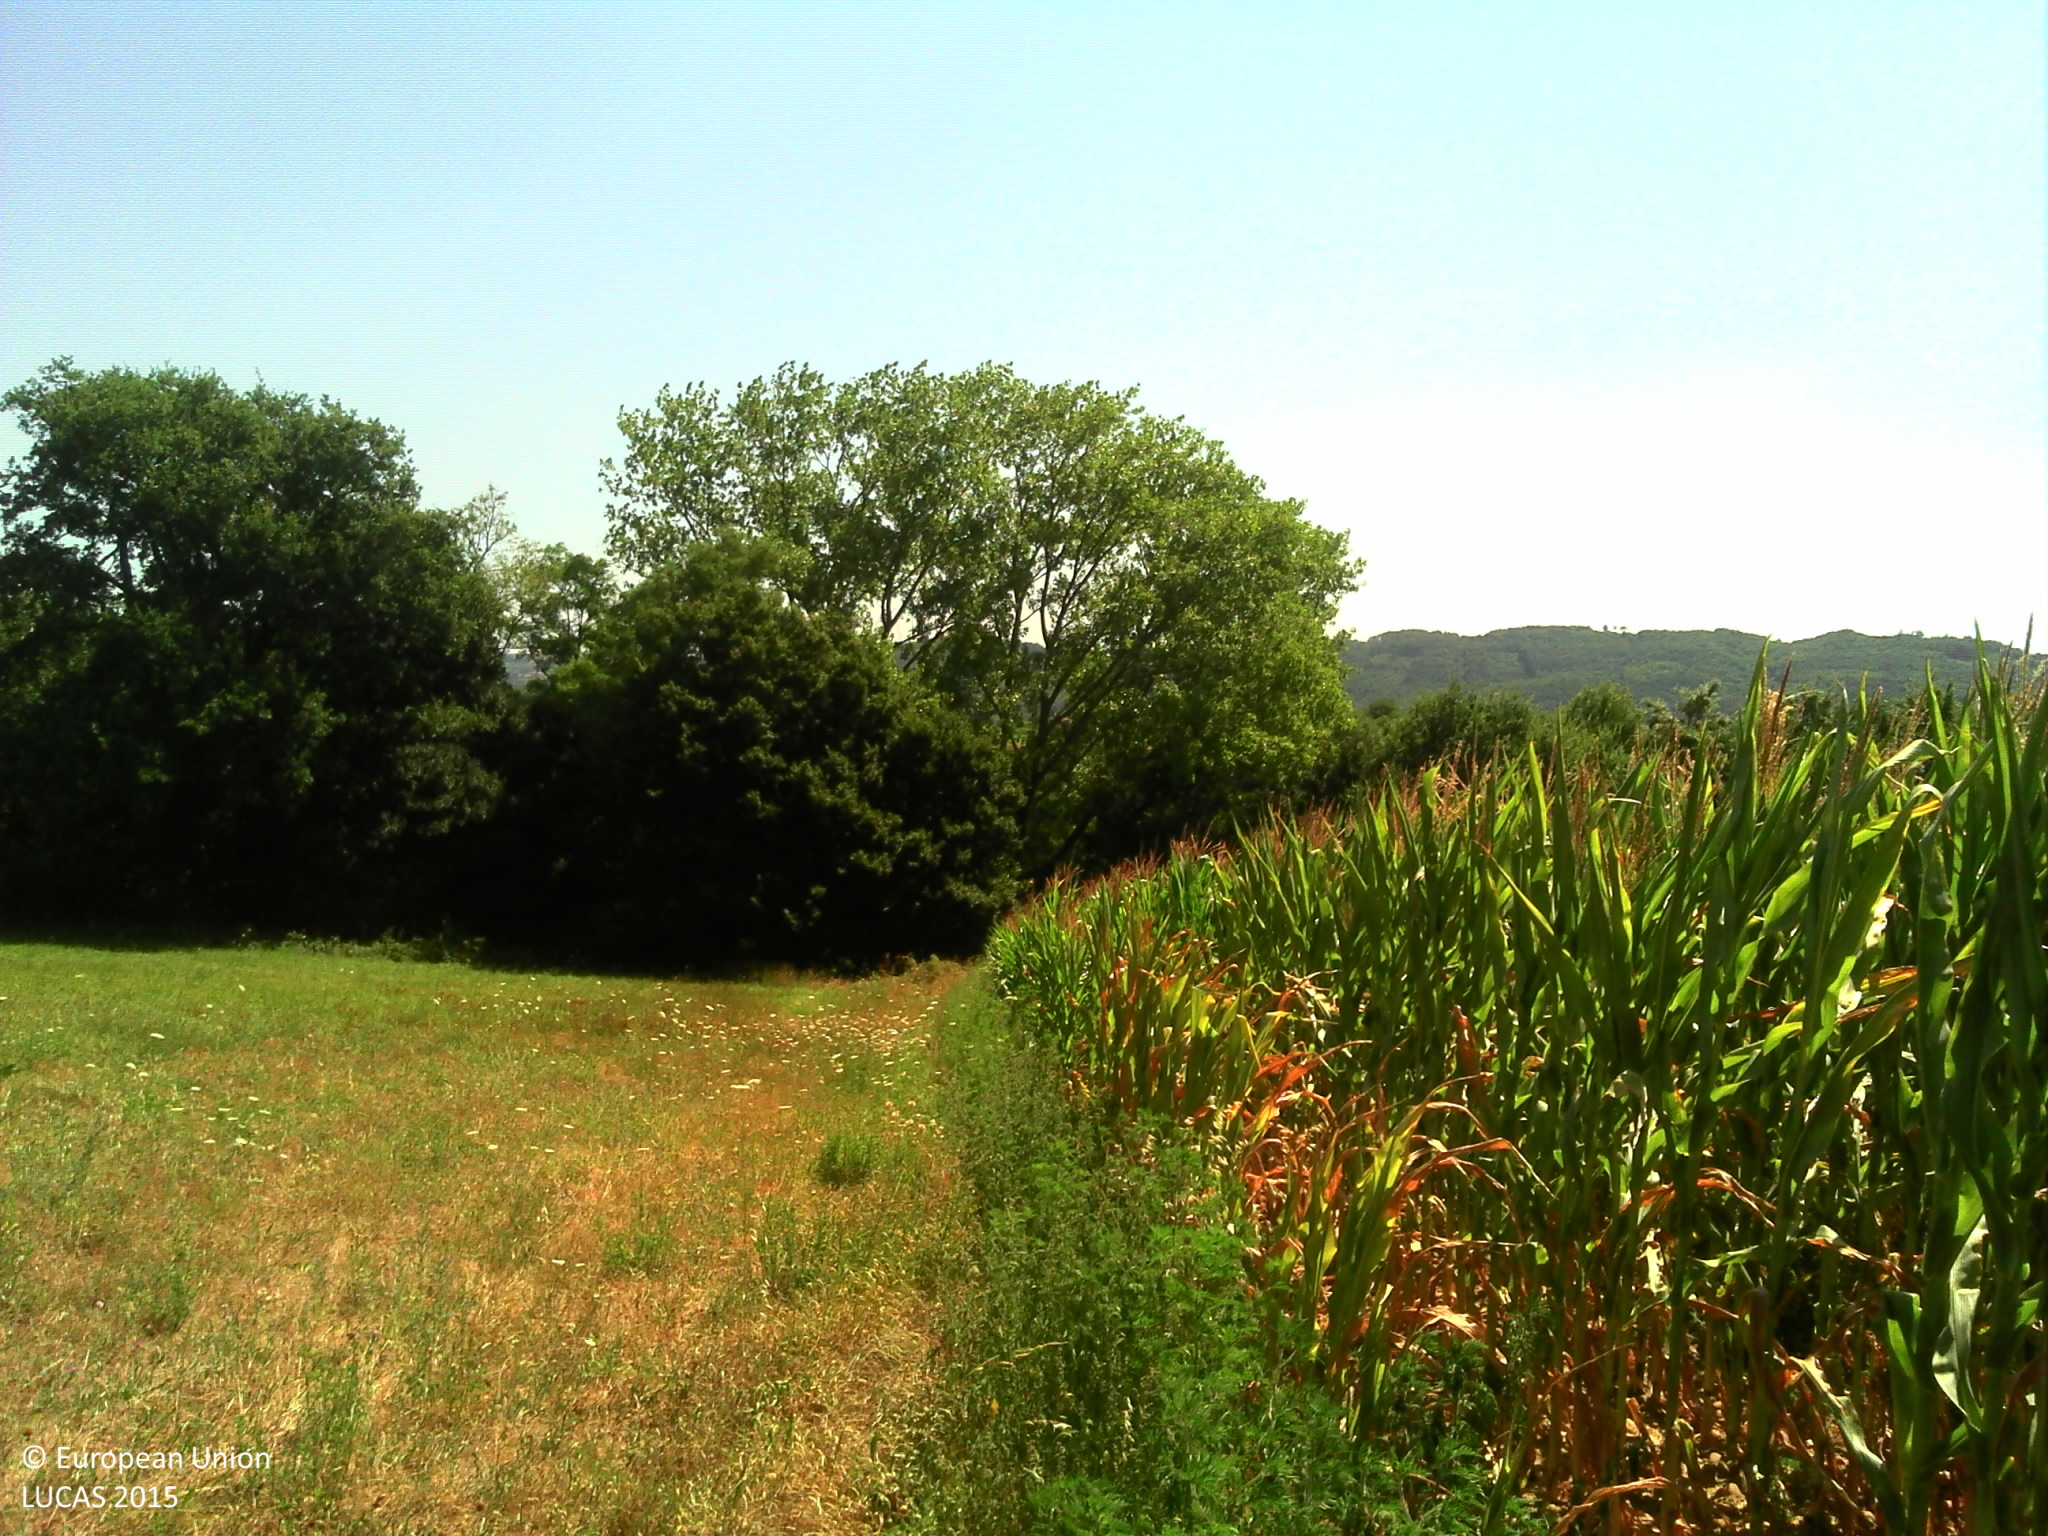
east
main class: Cropland
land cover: Maize
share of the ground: > 75 %
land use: Agriculture (excluding fallow land and kitchen gardens)
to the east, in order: Maize; Broadleaved woodland; Rivers and streams; Grassland without tree/shrub cover; Broadleaved woodland; Arable land (only in case pi)
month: July
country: FR
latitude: 45.2006
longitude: 4.9001
